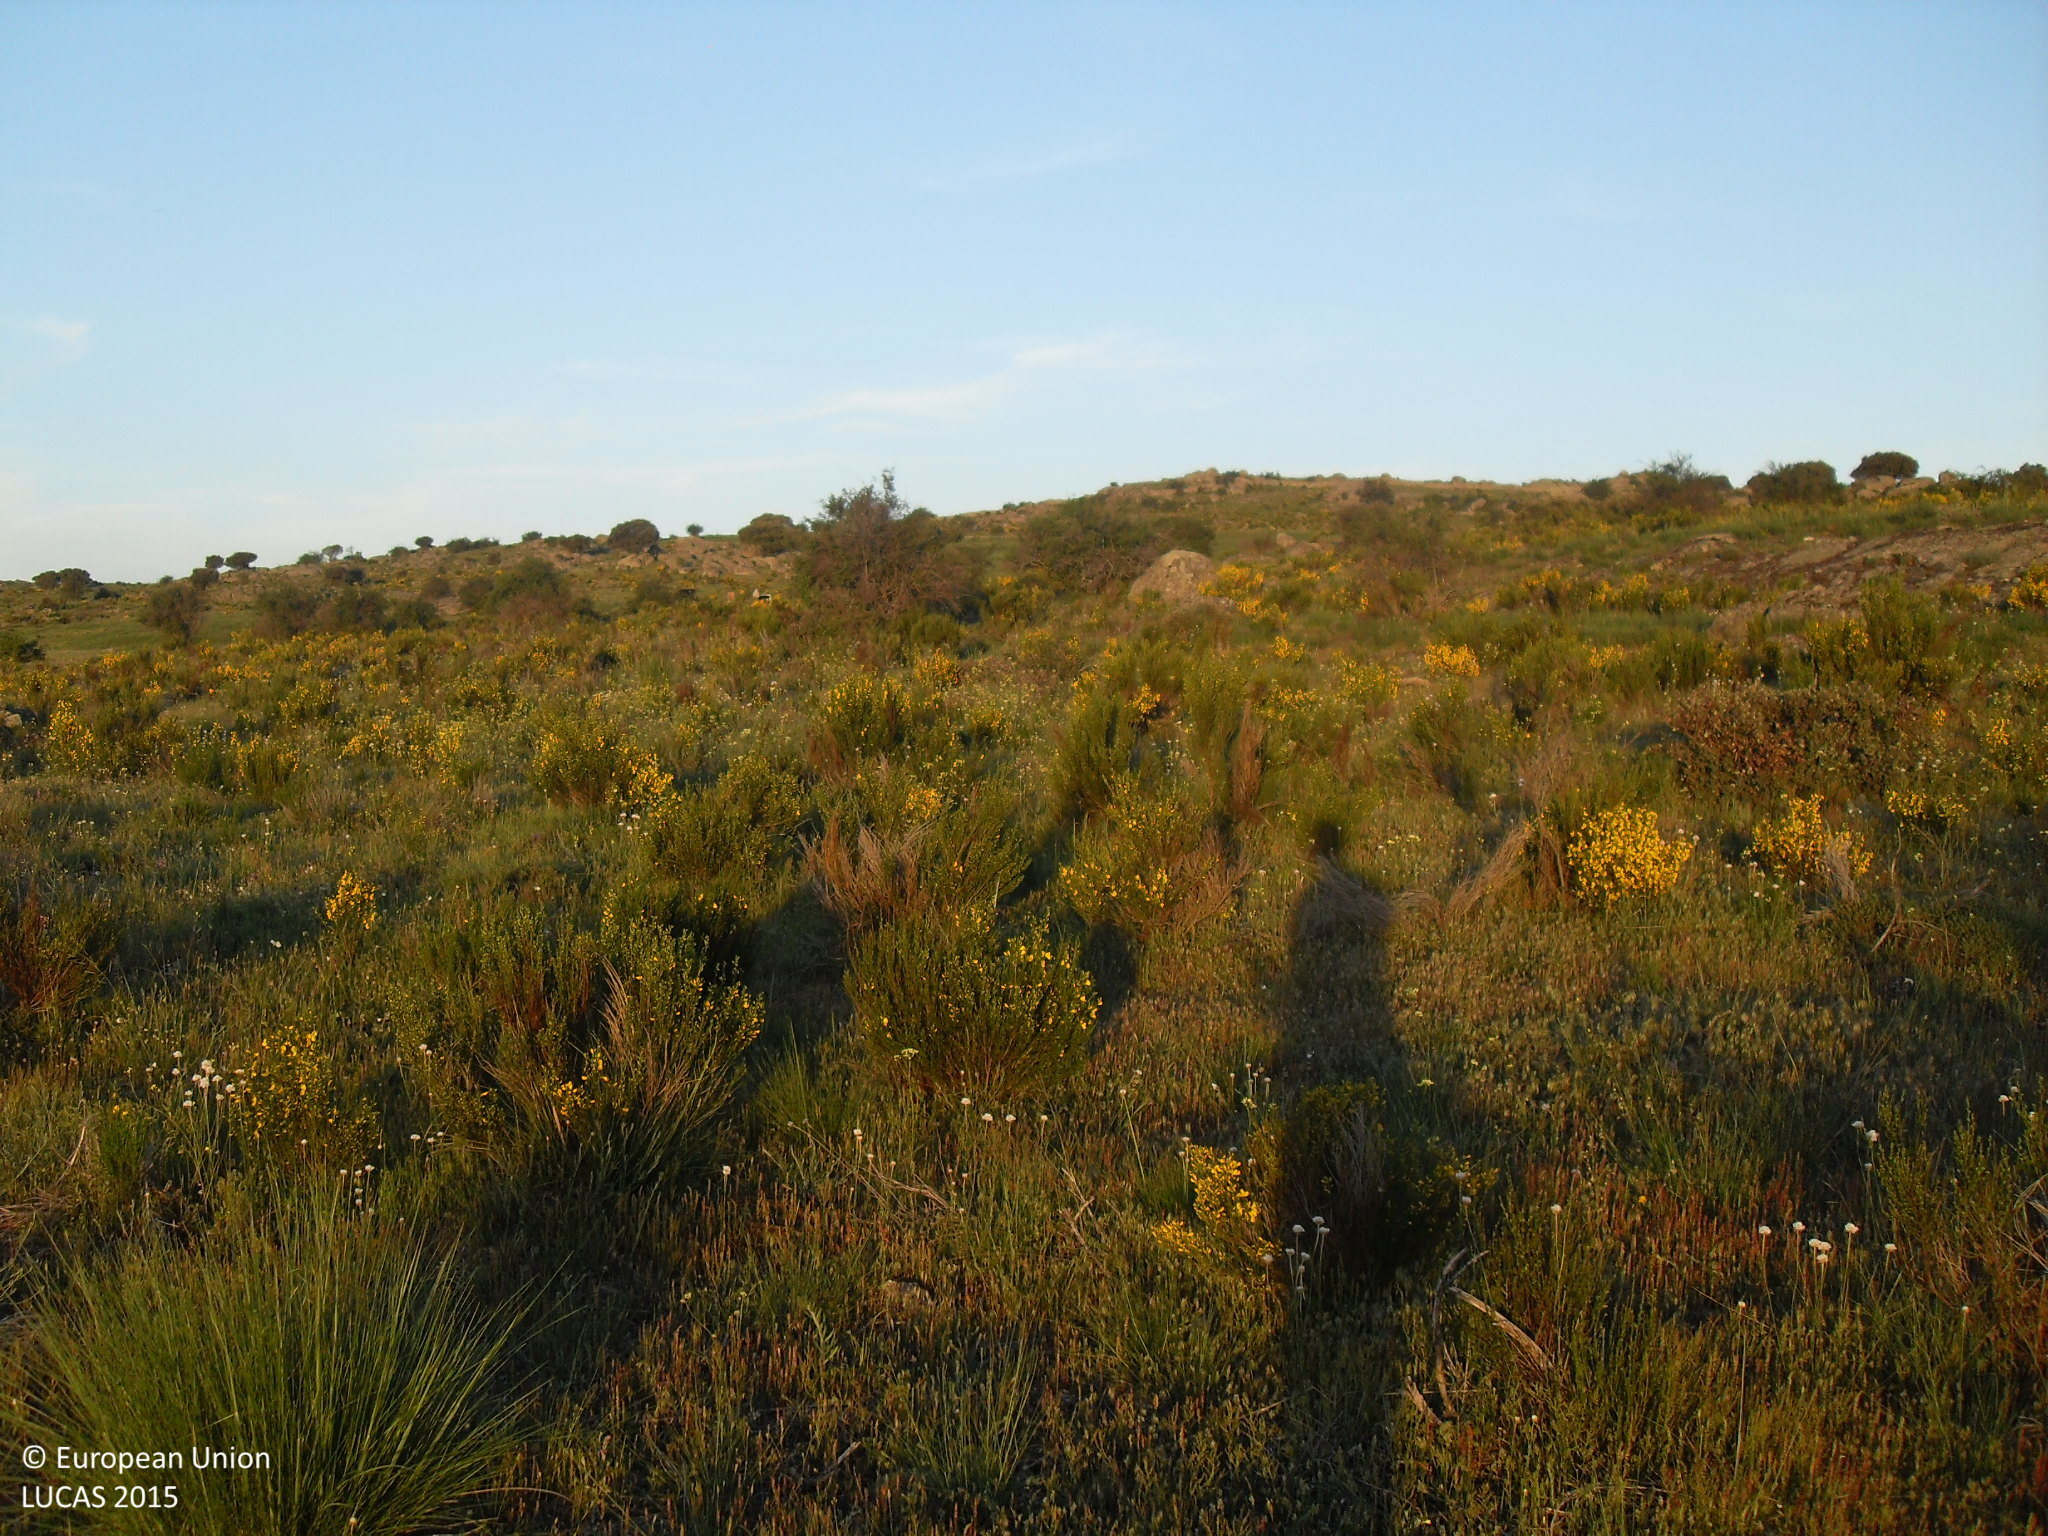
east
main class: Shrubland
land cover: Shrubland without tree cover
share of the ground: > 75 %
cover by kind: shrubs 100 %
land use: Agriculture (excluding fallow land and kitchen gardens)
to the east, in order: Shrubland without tree cover; Grassland without tree/shrub cover; Rocks and stones; Shrubland without tree cover
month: May
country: ES
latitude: 40.6458
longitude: -5.1403
